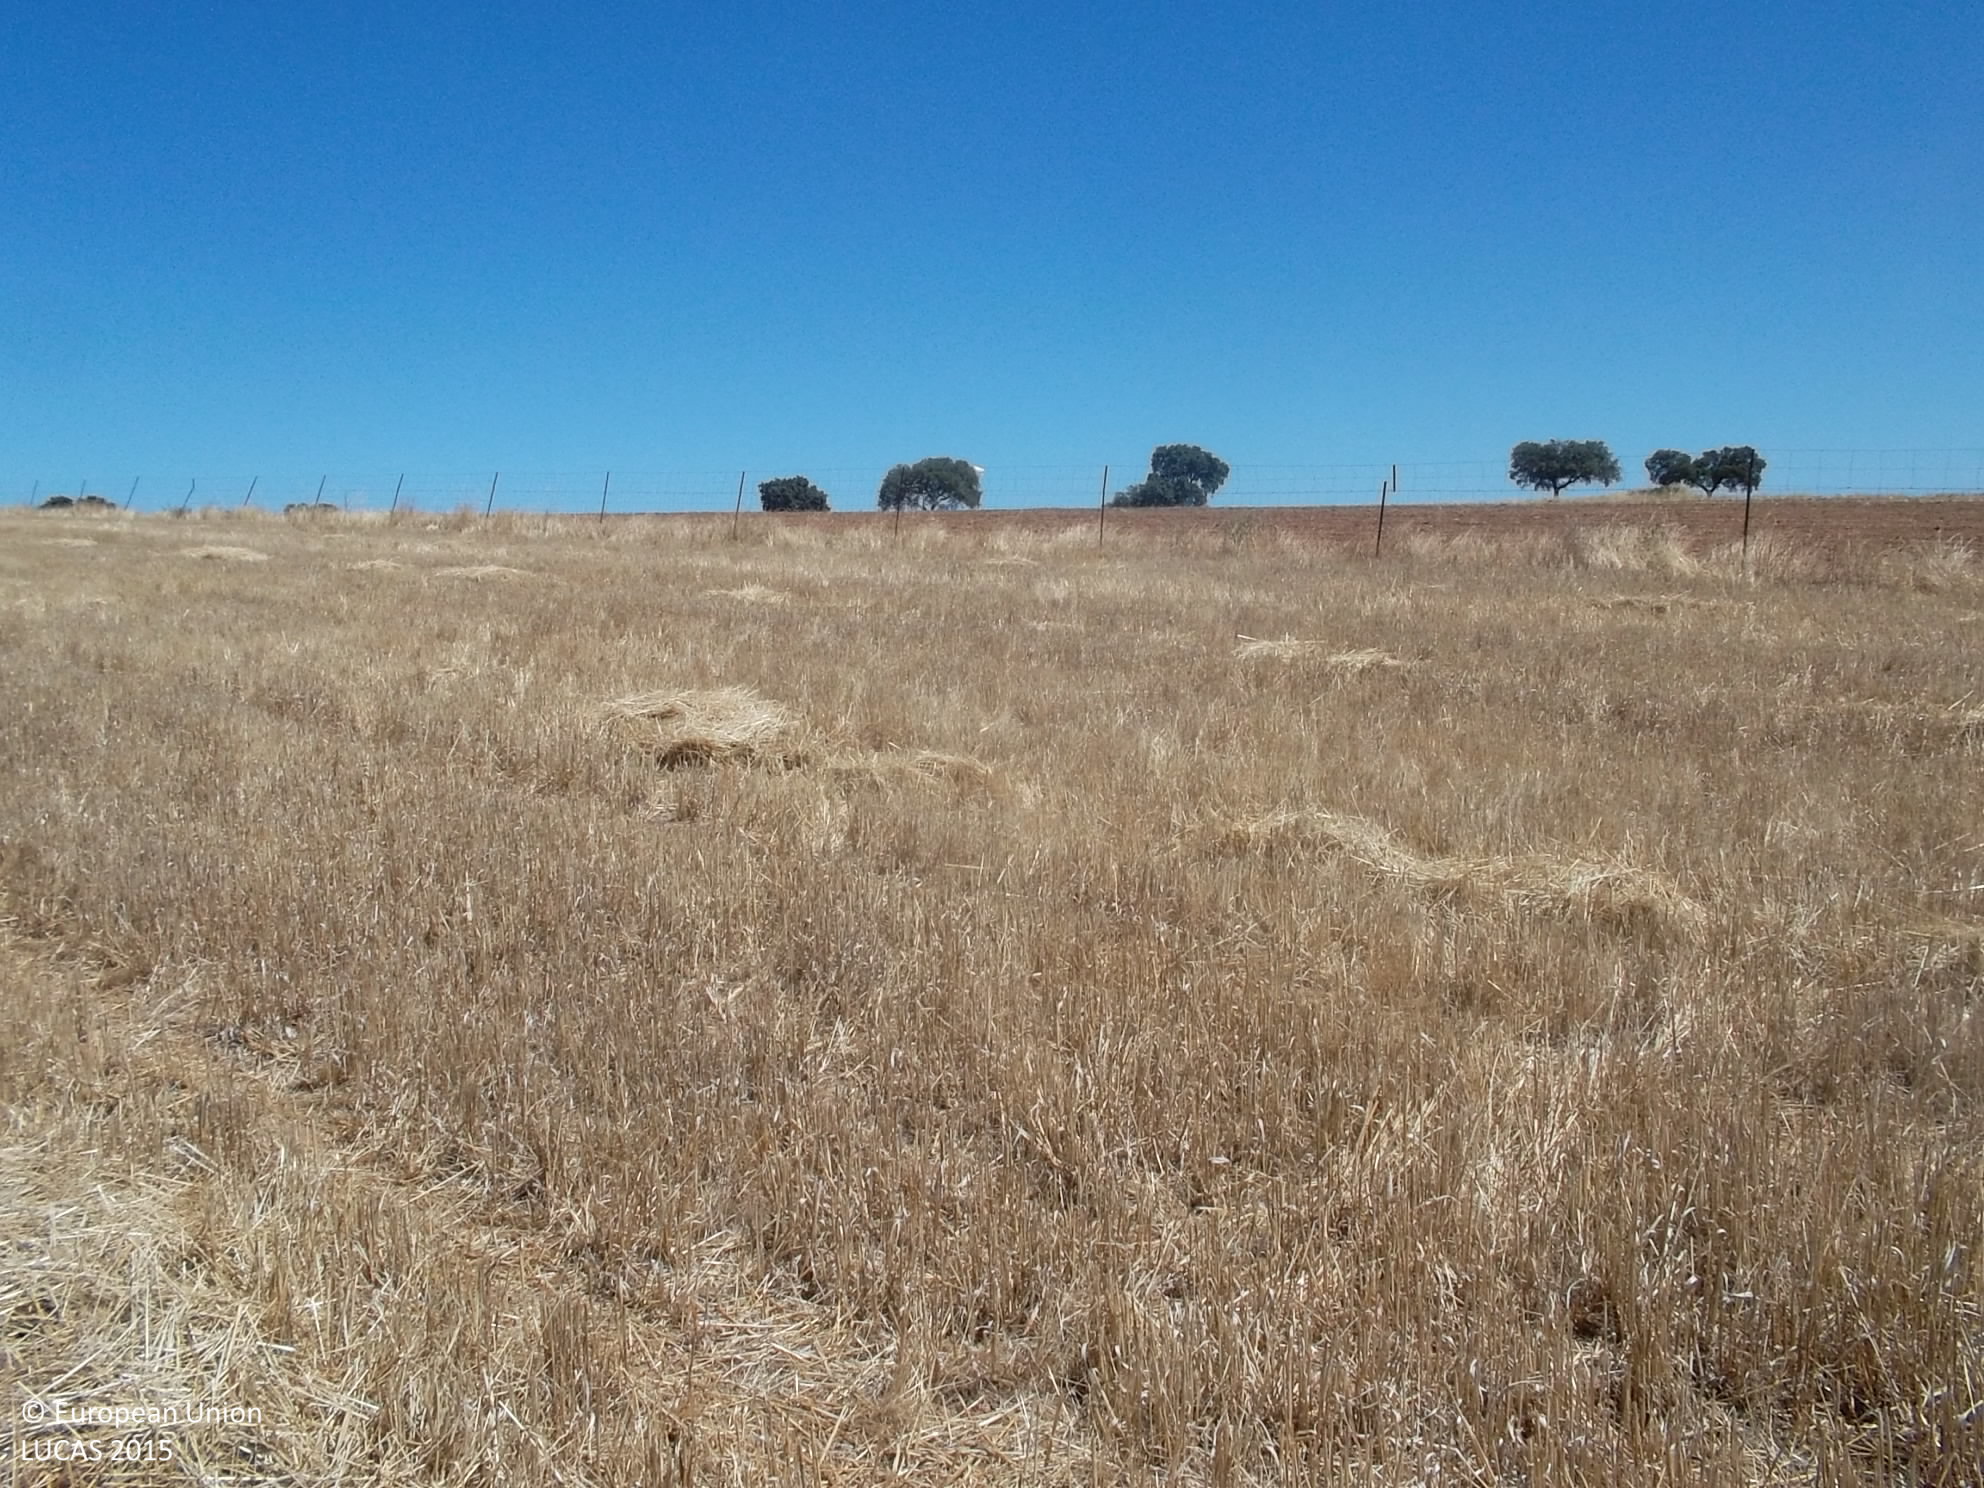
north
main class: Cropland
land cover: Oats
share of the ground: < 10 %
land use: Agriculture (excluding fallow land and kitchen gardens)
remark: Harvested field
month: July
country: ES
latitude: 38.4061
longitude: -5.8077
